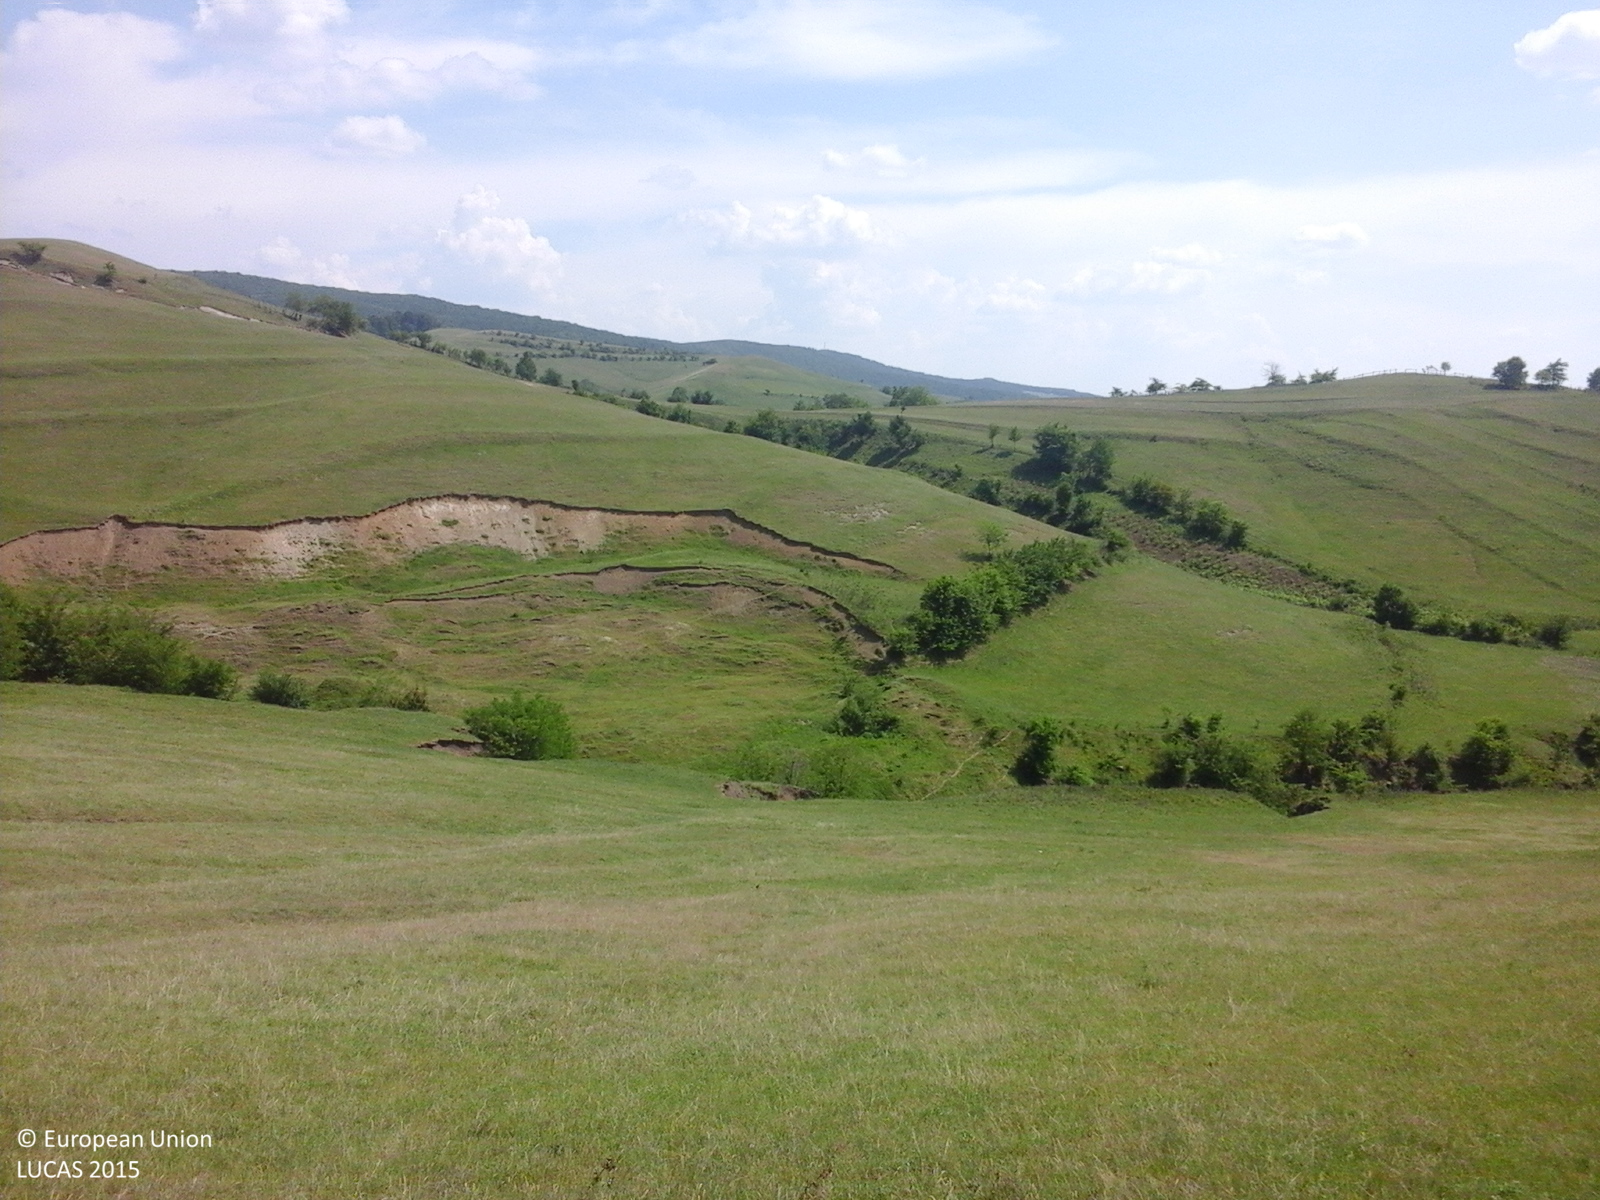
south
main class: Grassland
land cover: Grassland without tree/shrub cover
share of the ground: > 75 %
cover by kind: herbaceous plants 100 %
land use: Agriculture (excluding fallow land and kitchen gardens)
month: June
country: RO
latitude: 46.4273
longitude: 27.1331
